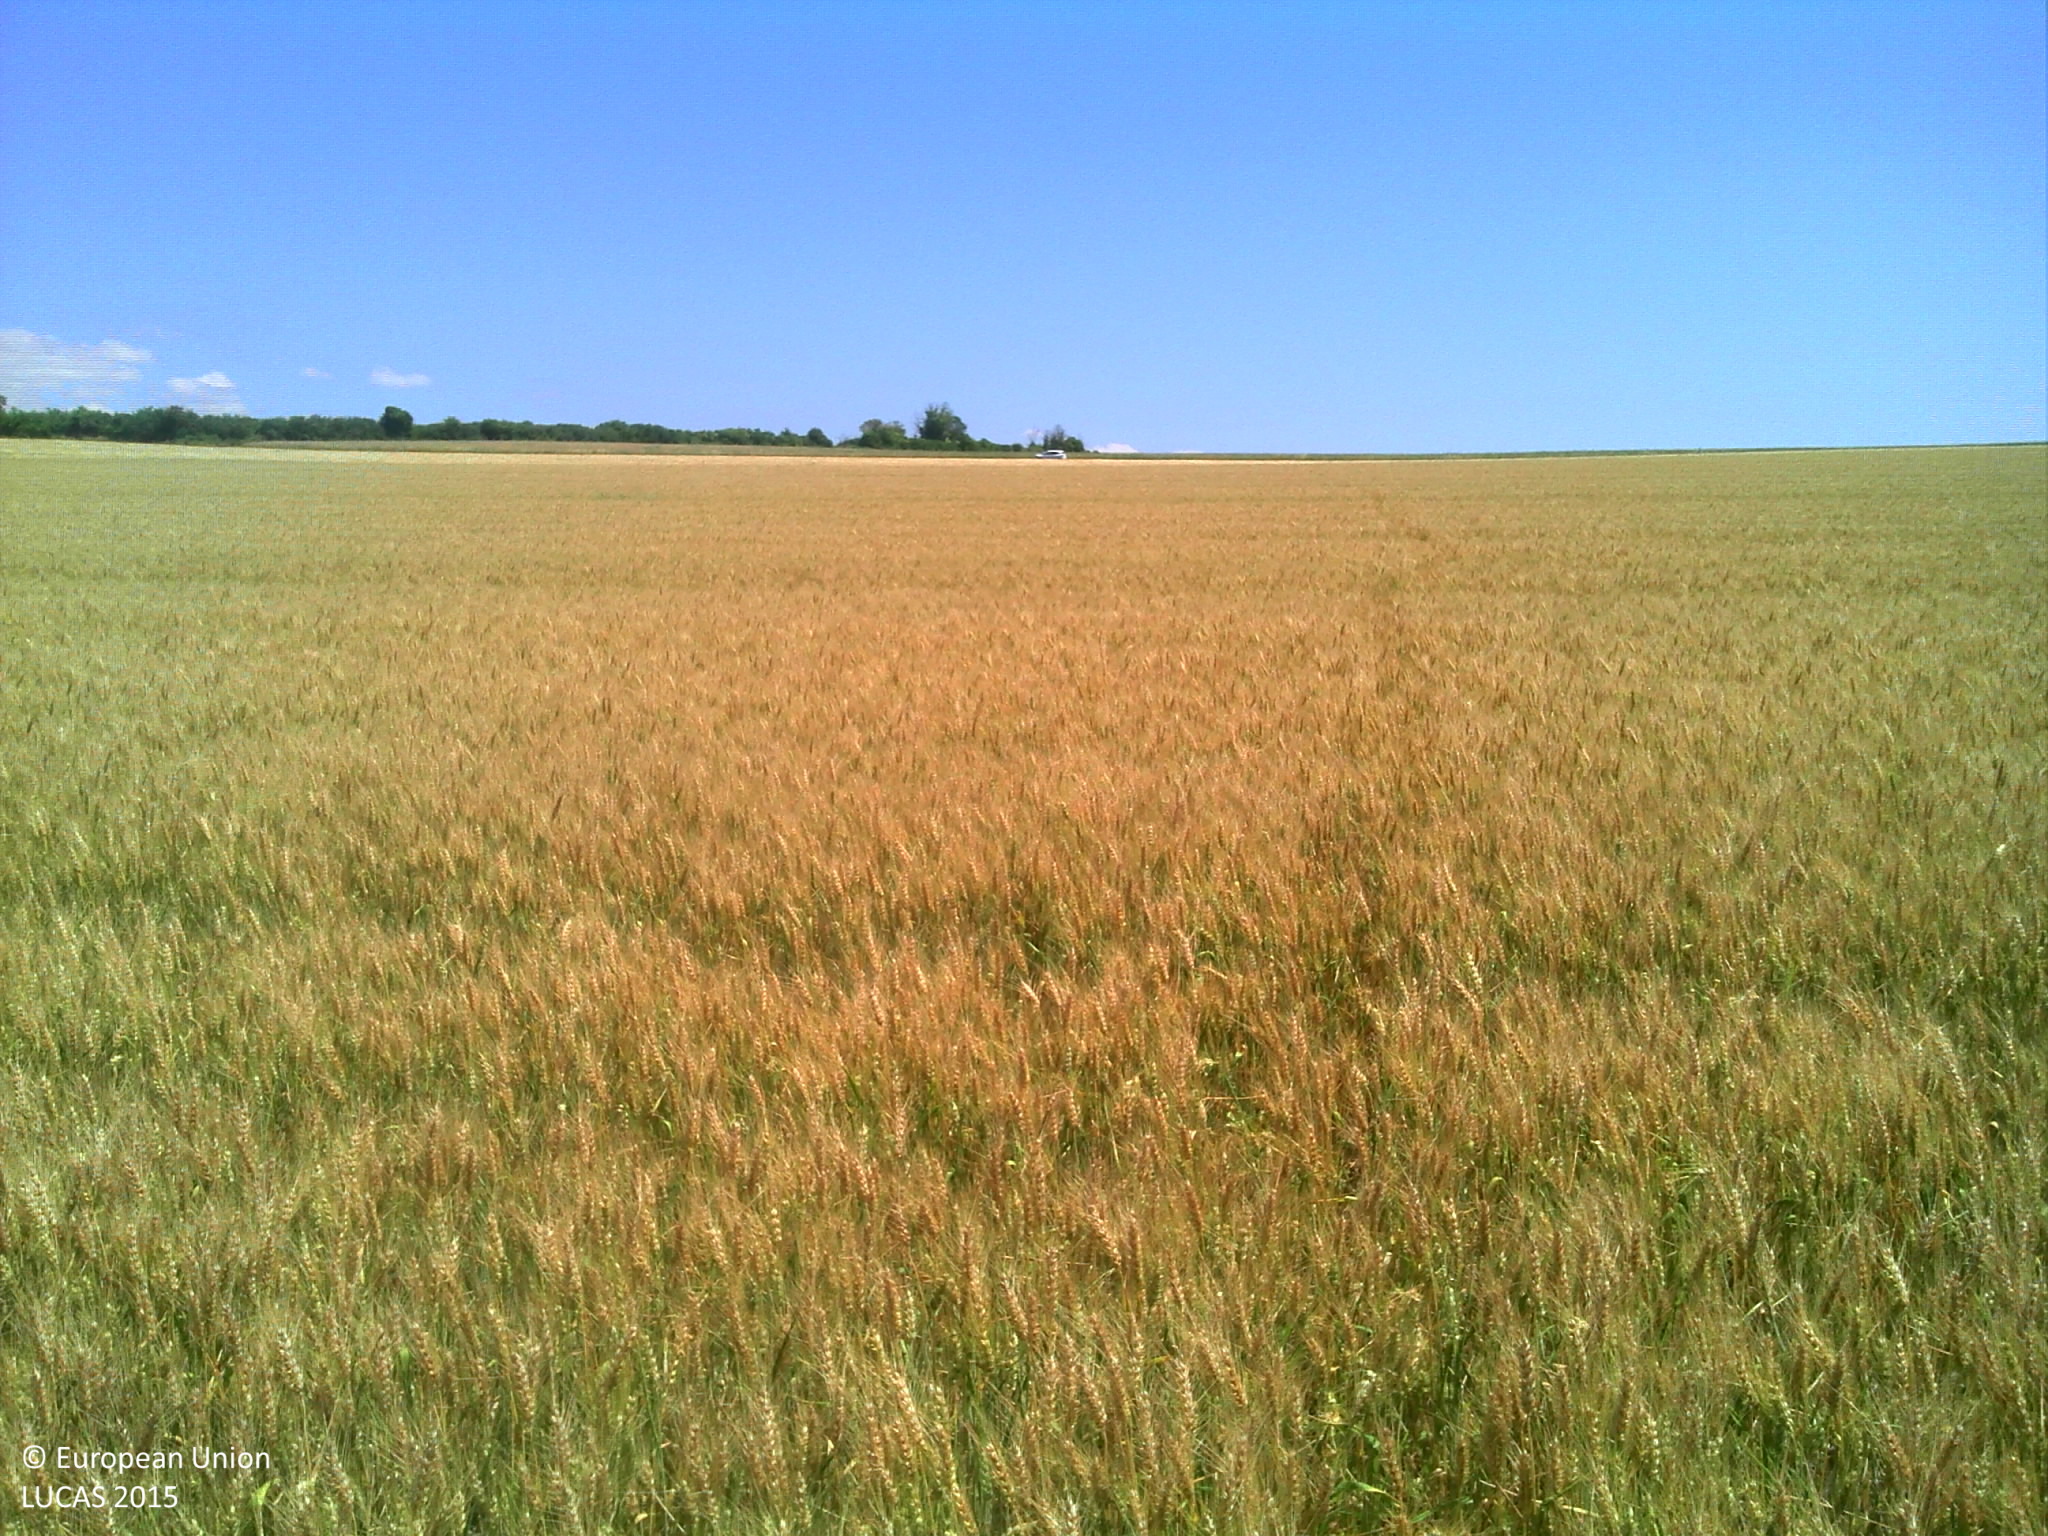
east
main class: Cropland
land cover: Durum wheat
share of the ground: > 75 %
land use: Agriculture (excluding fallow land and kitchen gardens)
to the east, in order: Durum wheat; Barley
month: June
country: FR
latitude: 45.5613
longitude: -0.8512
